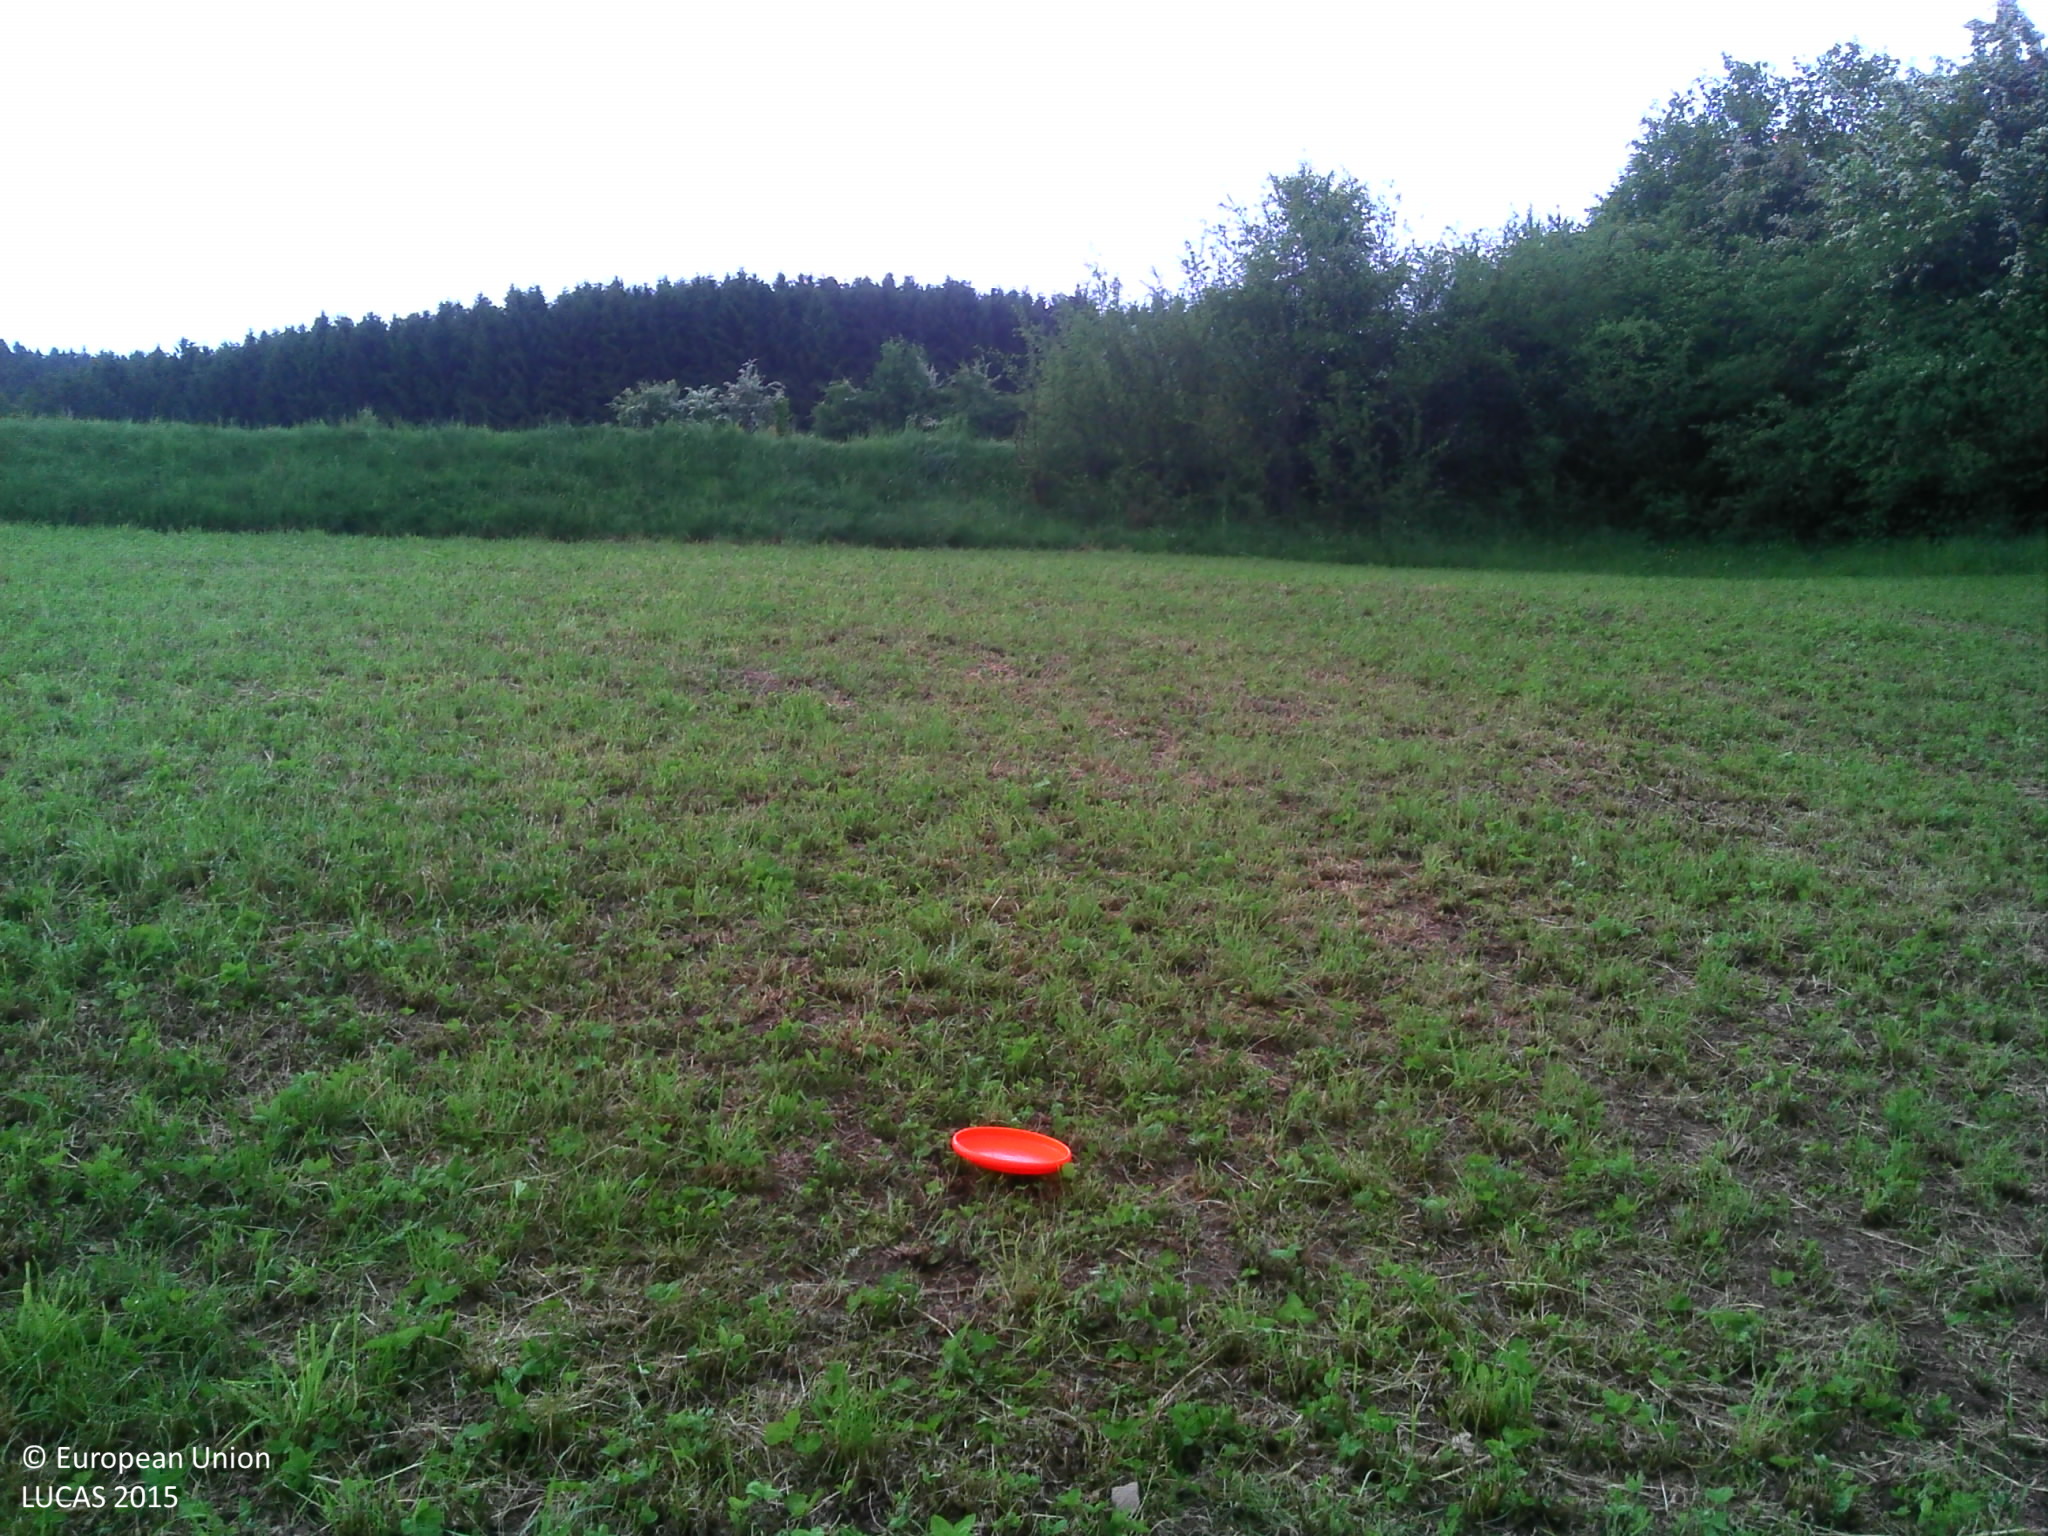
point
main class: Grassland
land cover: Grassland without tree/shrub cover
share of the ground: > 75 %
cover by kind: herbaceous plants 100 %
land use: Agriculture (excluding fallow land and kitchen gardens)
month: June
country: BE
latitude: 50.3219
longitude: 5.7710
